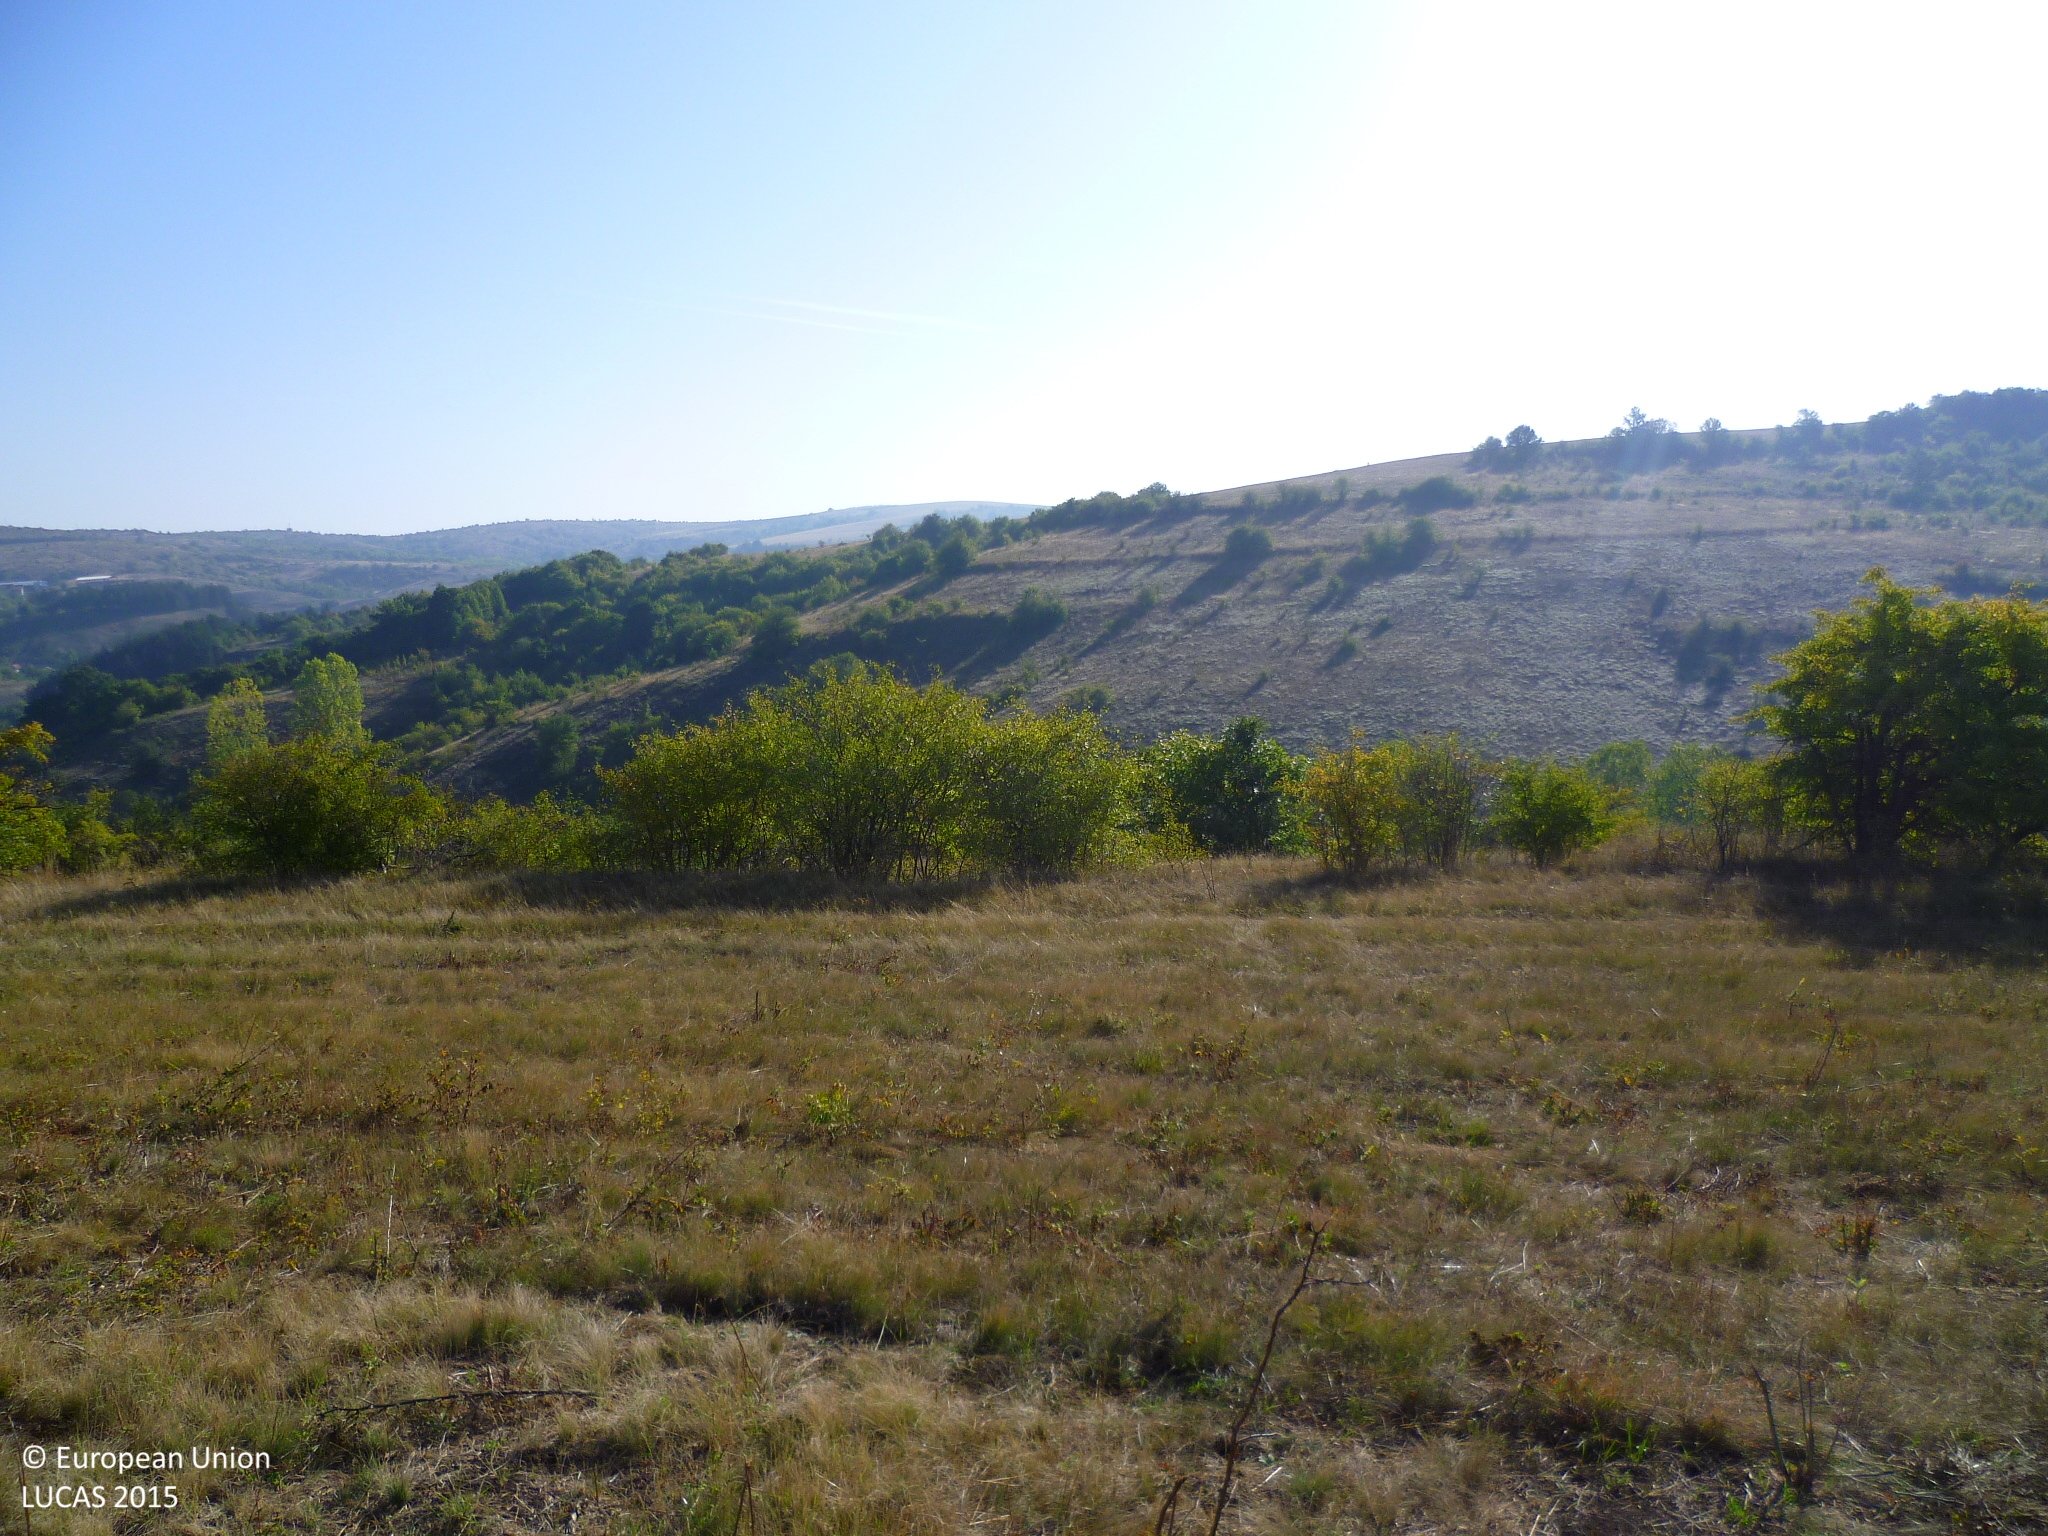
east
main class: Grassland
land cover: Grassland without tree/shrub cover
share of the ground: > 75 %
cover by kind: herbaceous plants 100 %
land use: Agriculture (excluding fallow land and kitchen gardens)
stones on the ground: < 10 %
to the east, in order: Grassland without tree/shrub cover; Grassland with sparse tree/shrub cover; Tracks; Broadleaved woodland; Grassland with sparse tree/shrub cover; Abandoned hedges; Grassland without tree/shrub cover
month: September
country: BG
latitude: 42.7533
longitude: 23.0678
